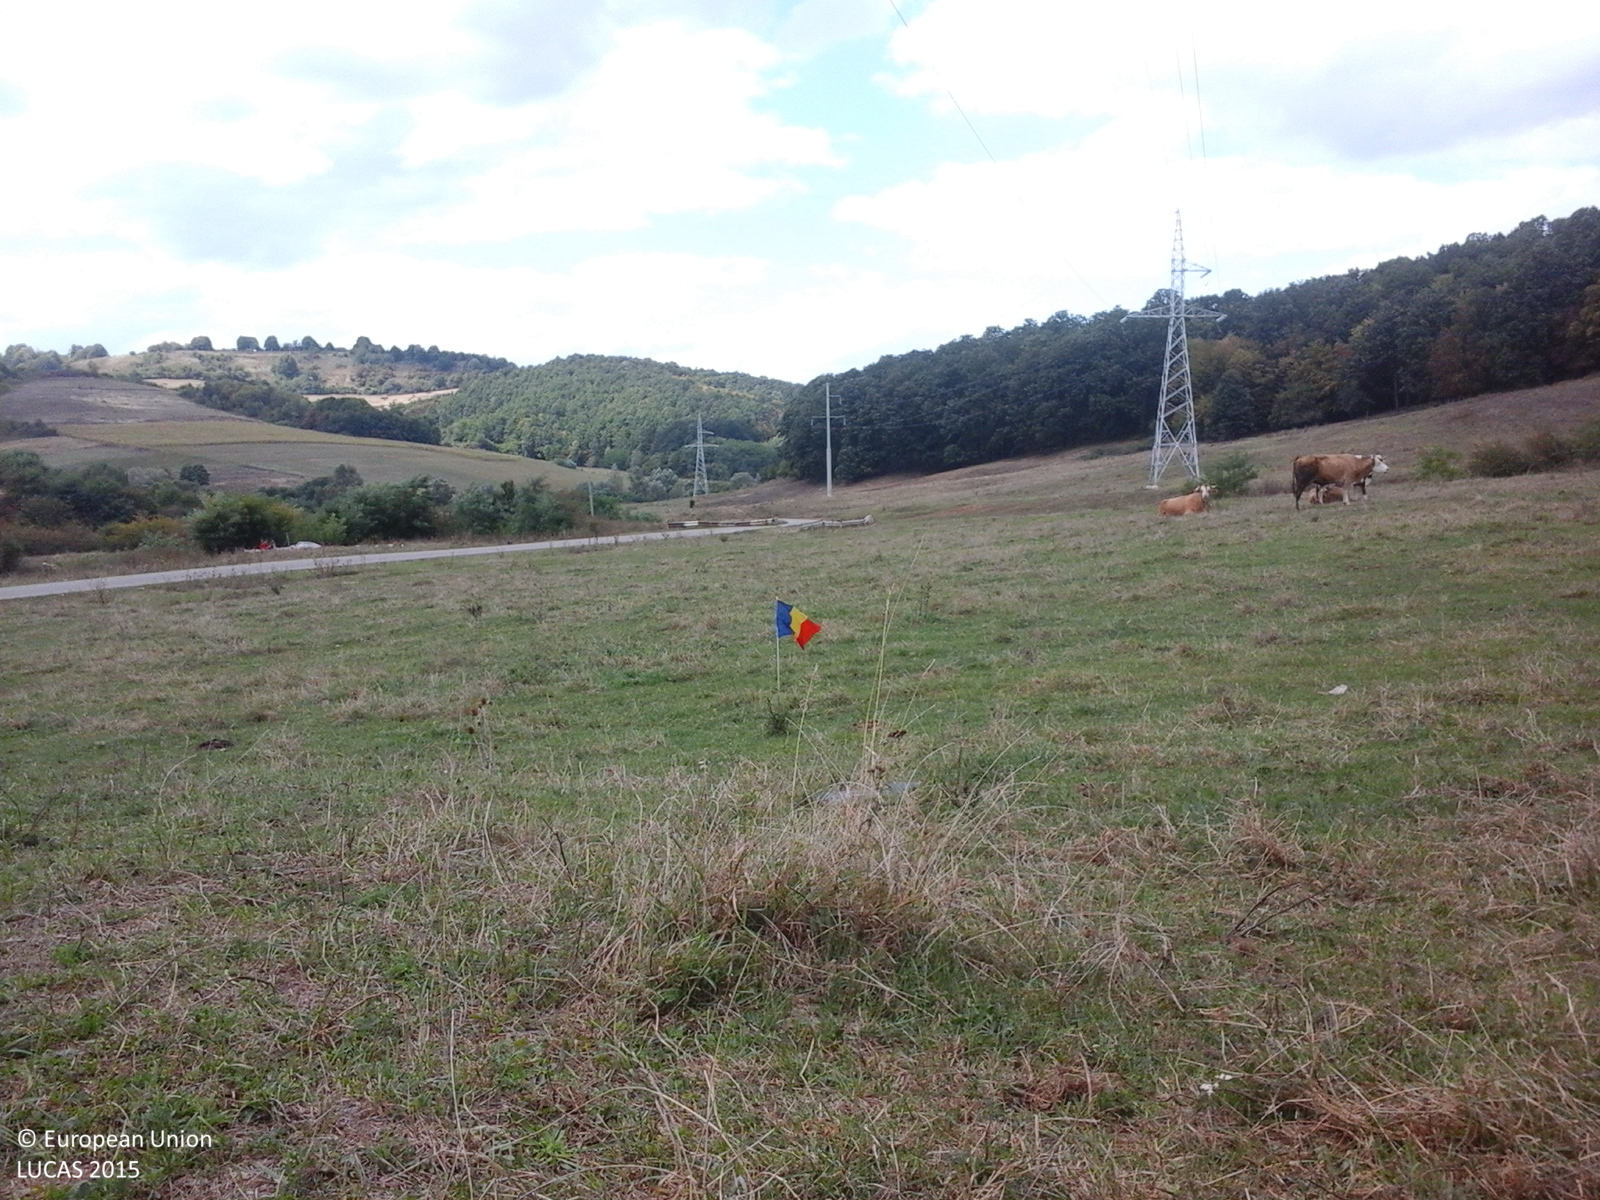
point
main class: Grassland
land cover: Grassland without tree/shrub cover
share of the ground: > 75 %
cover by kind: herbaceous plants 100 %
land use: Agriculture (excluding fallow land and kitchen gardens)
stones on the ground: < 10 %
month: September
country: RO
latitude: 47.3301
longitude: 23.2346
